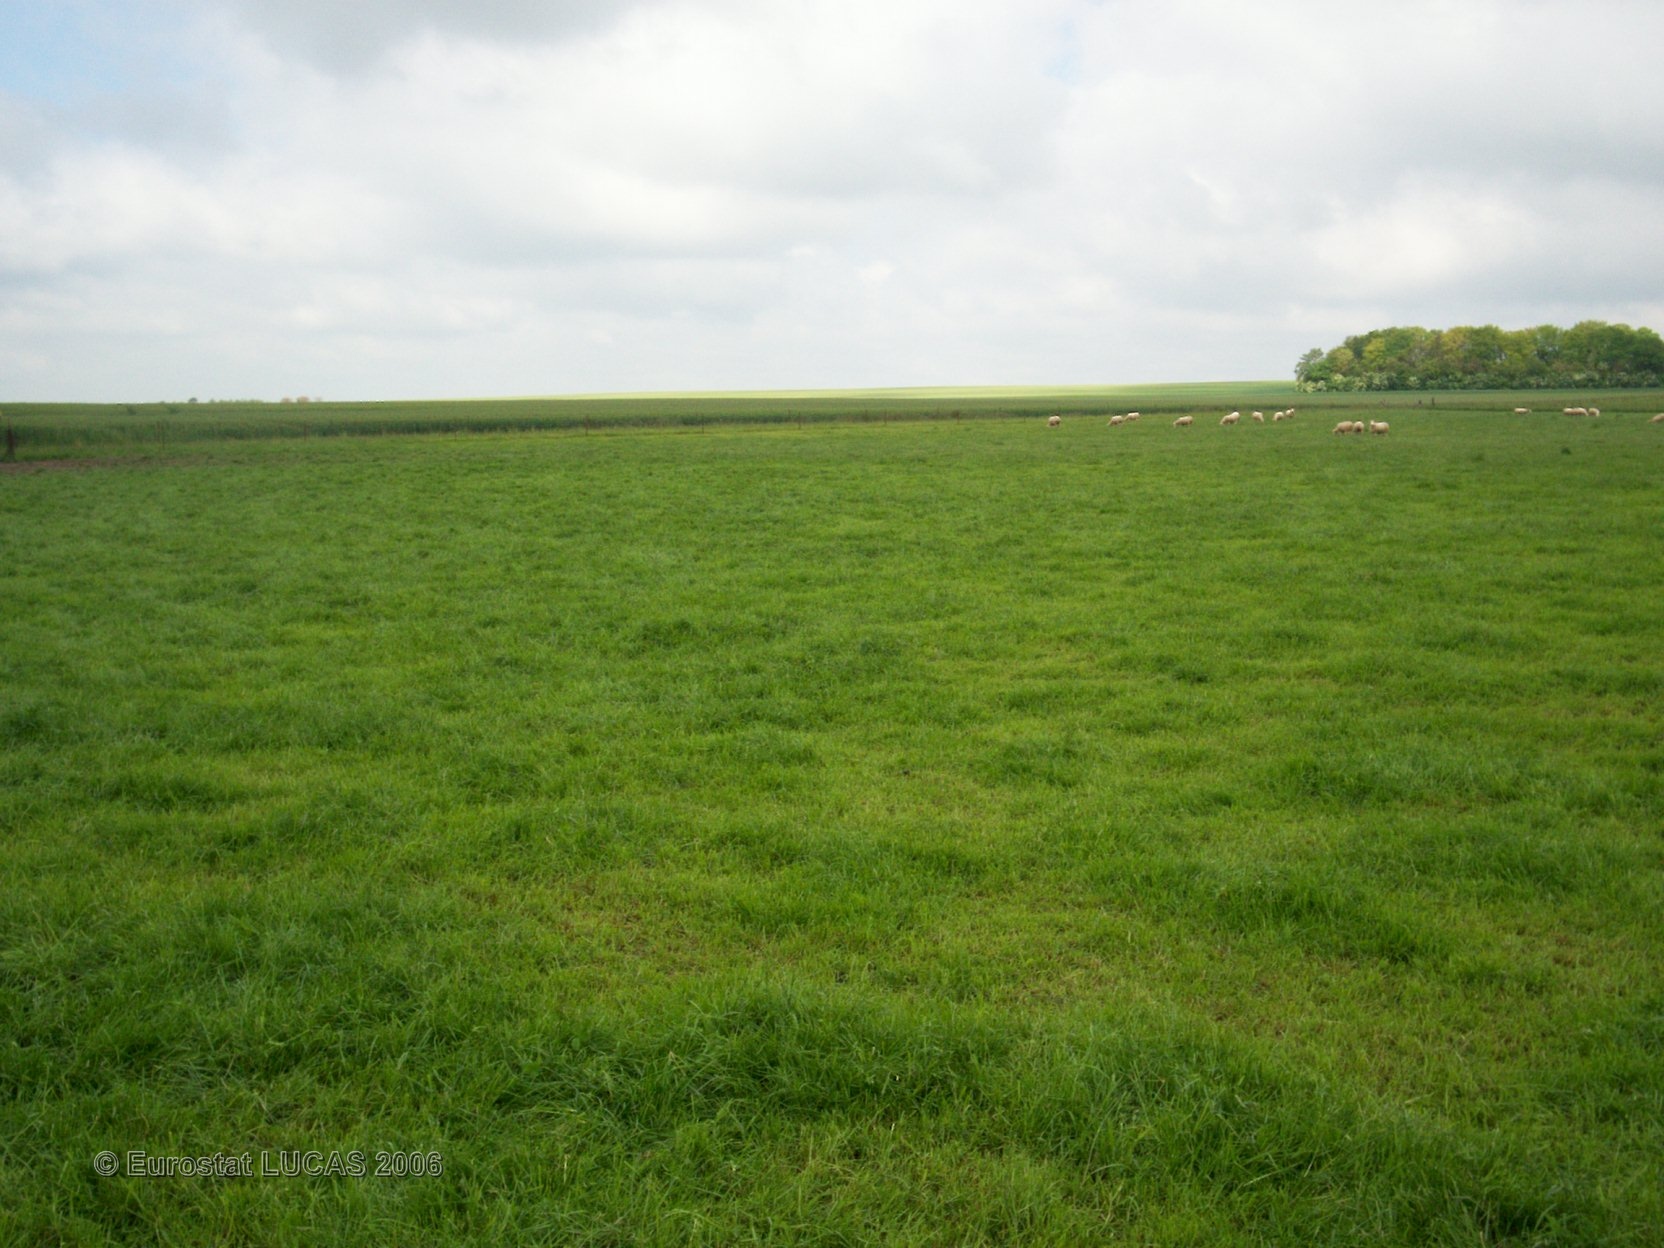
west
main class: Grassland
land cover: Grassland without tree/shrub cover
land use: Agriculture (excluding fallow land and kitchen gardens)
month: June
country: FR
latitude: 48.5530
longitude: 4.4560
